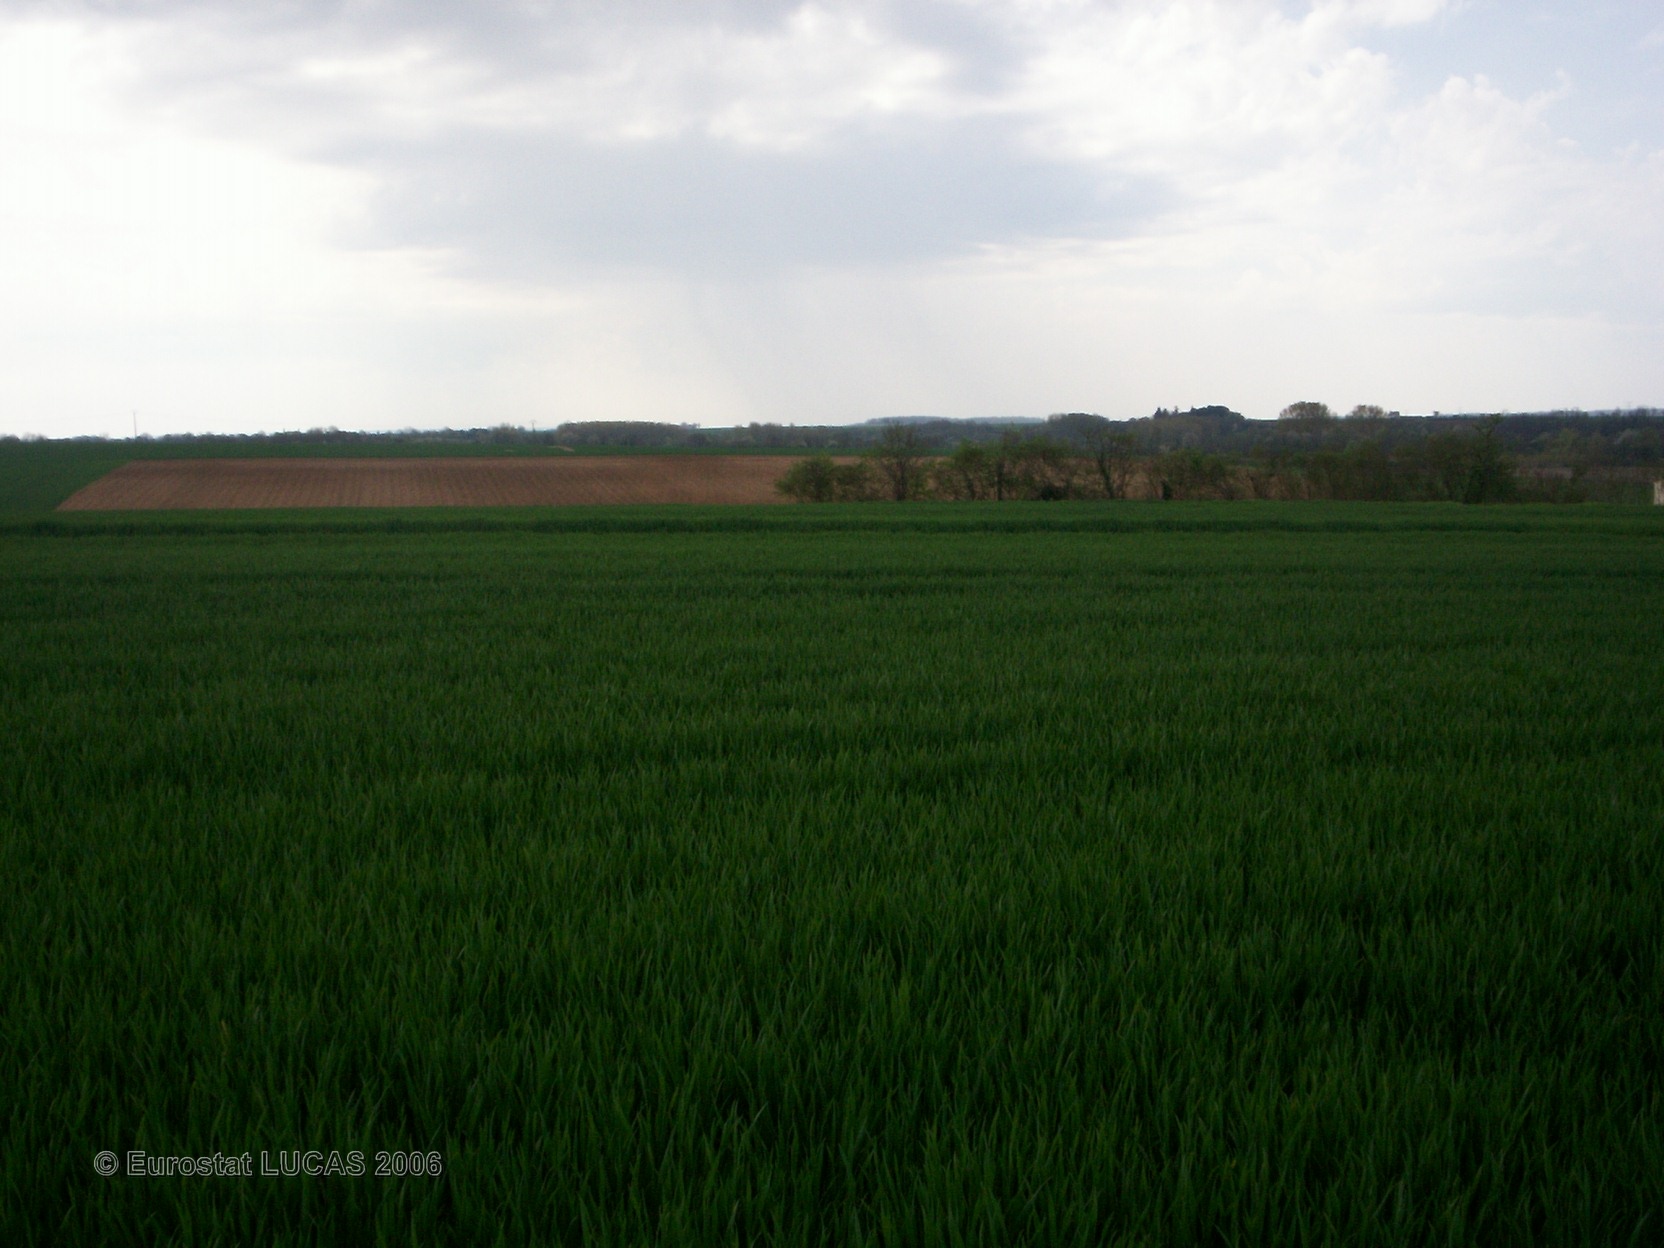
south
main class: Cropland
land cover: Common wheat
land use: Agriculture (excluding fallow land and kitchen gardens)
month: April
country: FR
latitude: 47.3535
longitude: 3.0446
